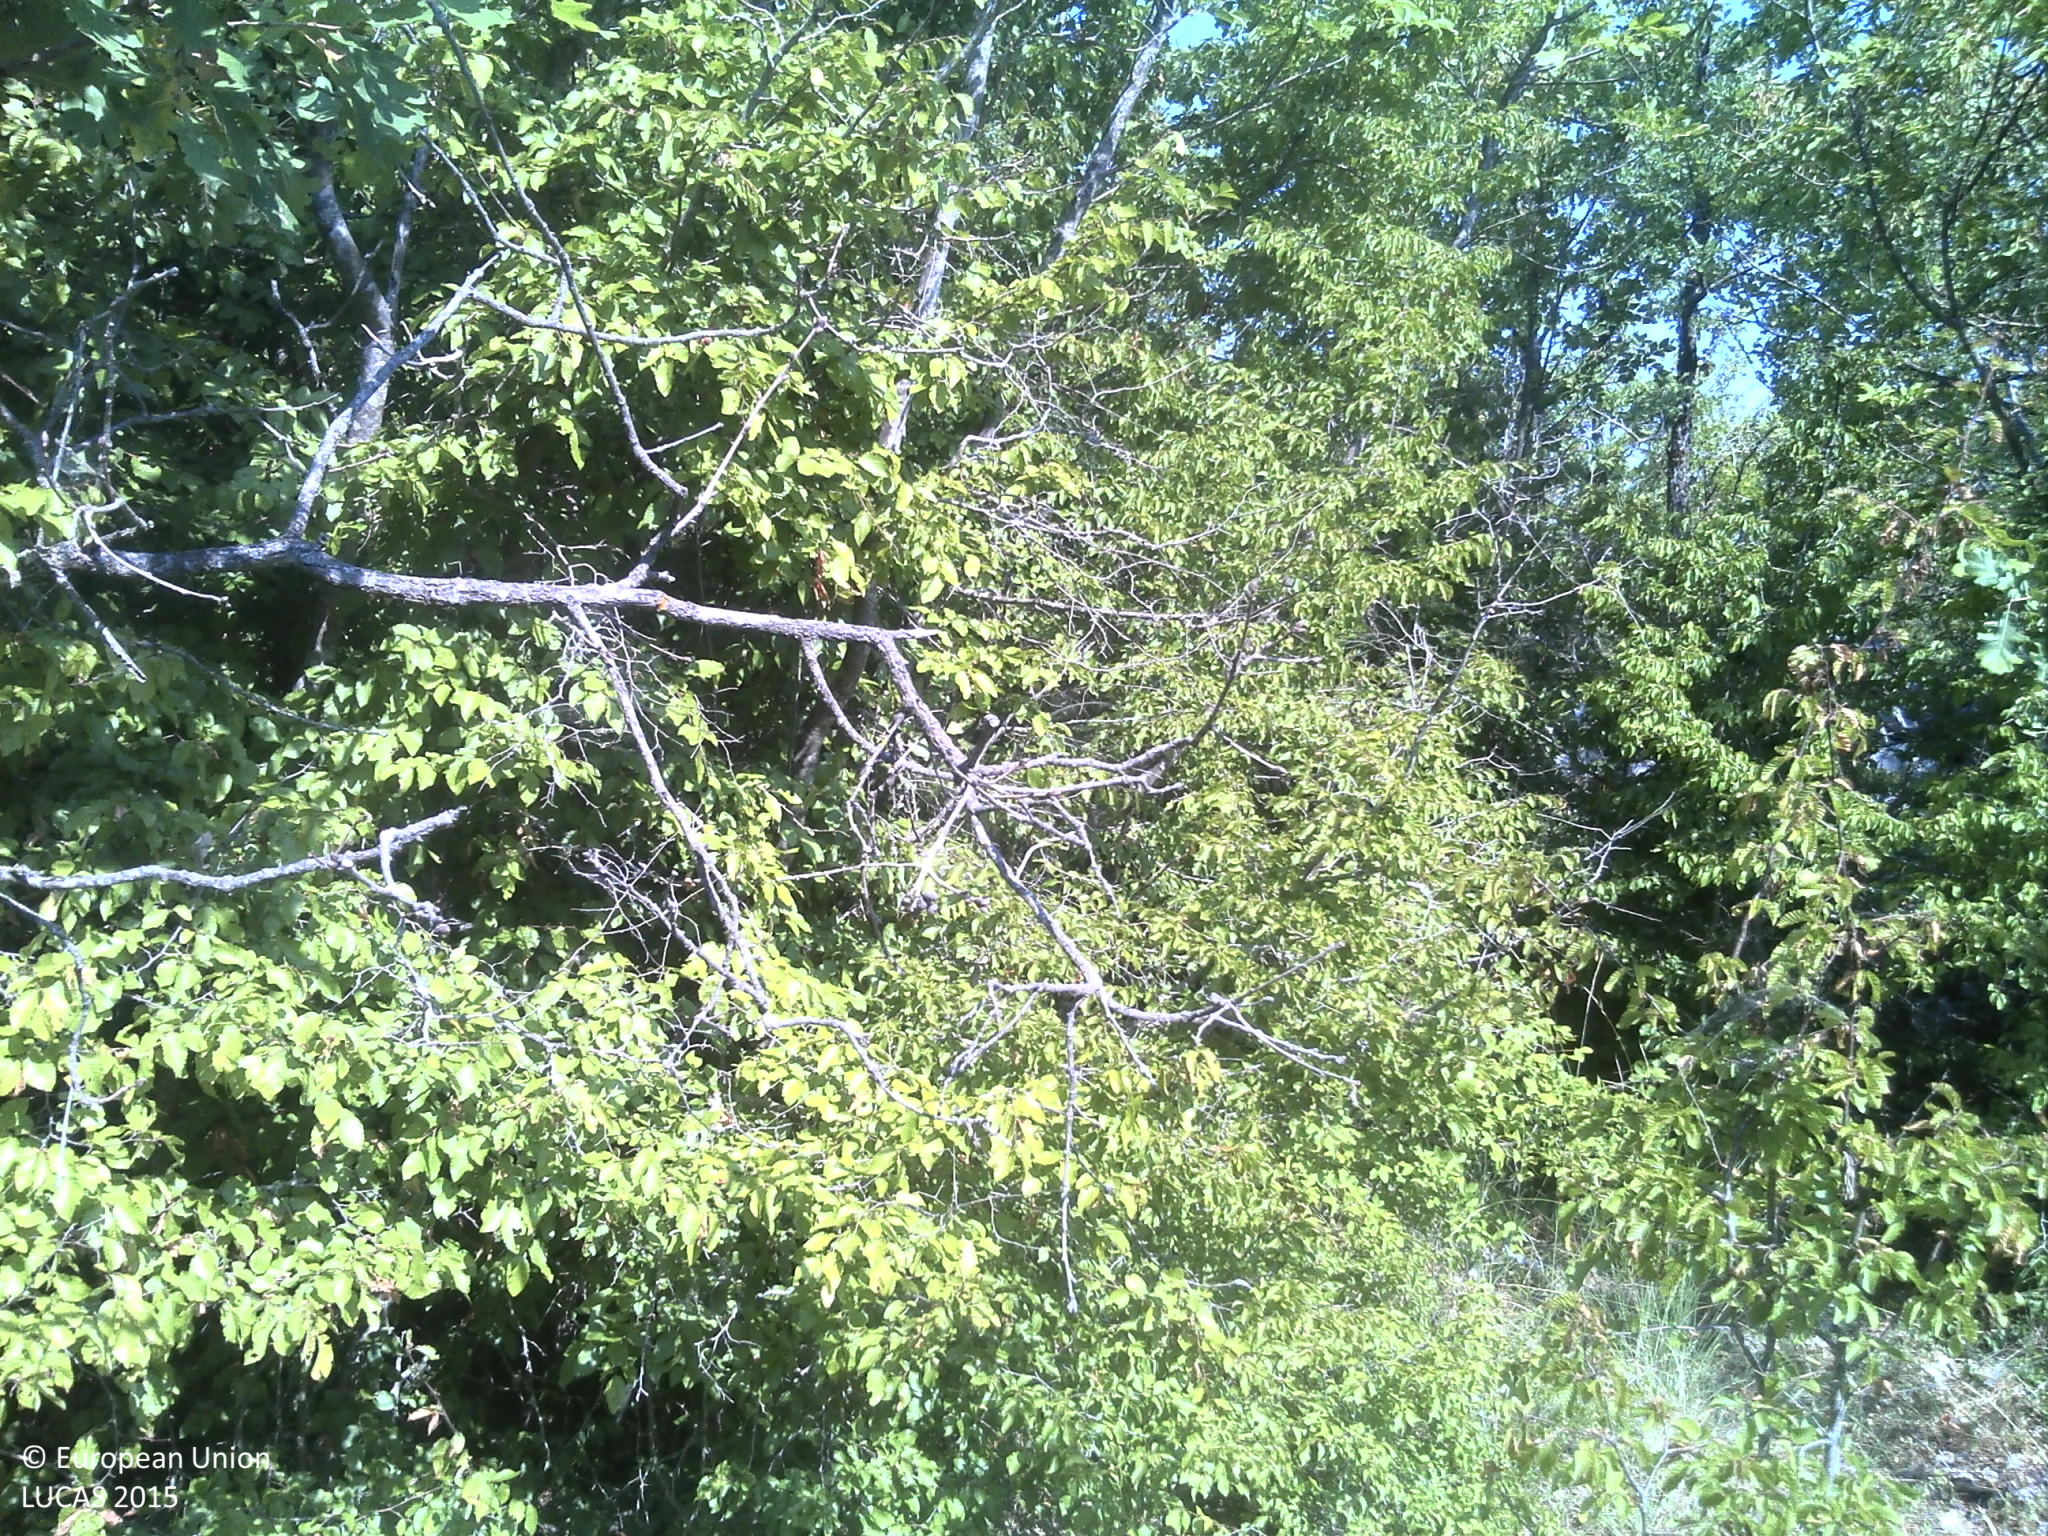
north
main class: Woodland
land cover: Broadleaved woodland
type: thermophilous deciduous forest
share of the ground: > 75 %
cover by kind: broadleaved forest trees 50 %, shrubs 35 %, herbaceous plants 10 %, consolidated bare surface 5 %
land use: Semi-natural and natural areas not in use
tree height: > 5 m
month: July
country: HR
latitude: 43.3537
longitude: 17.2585
